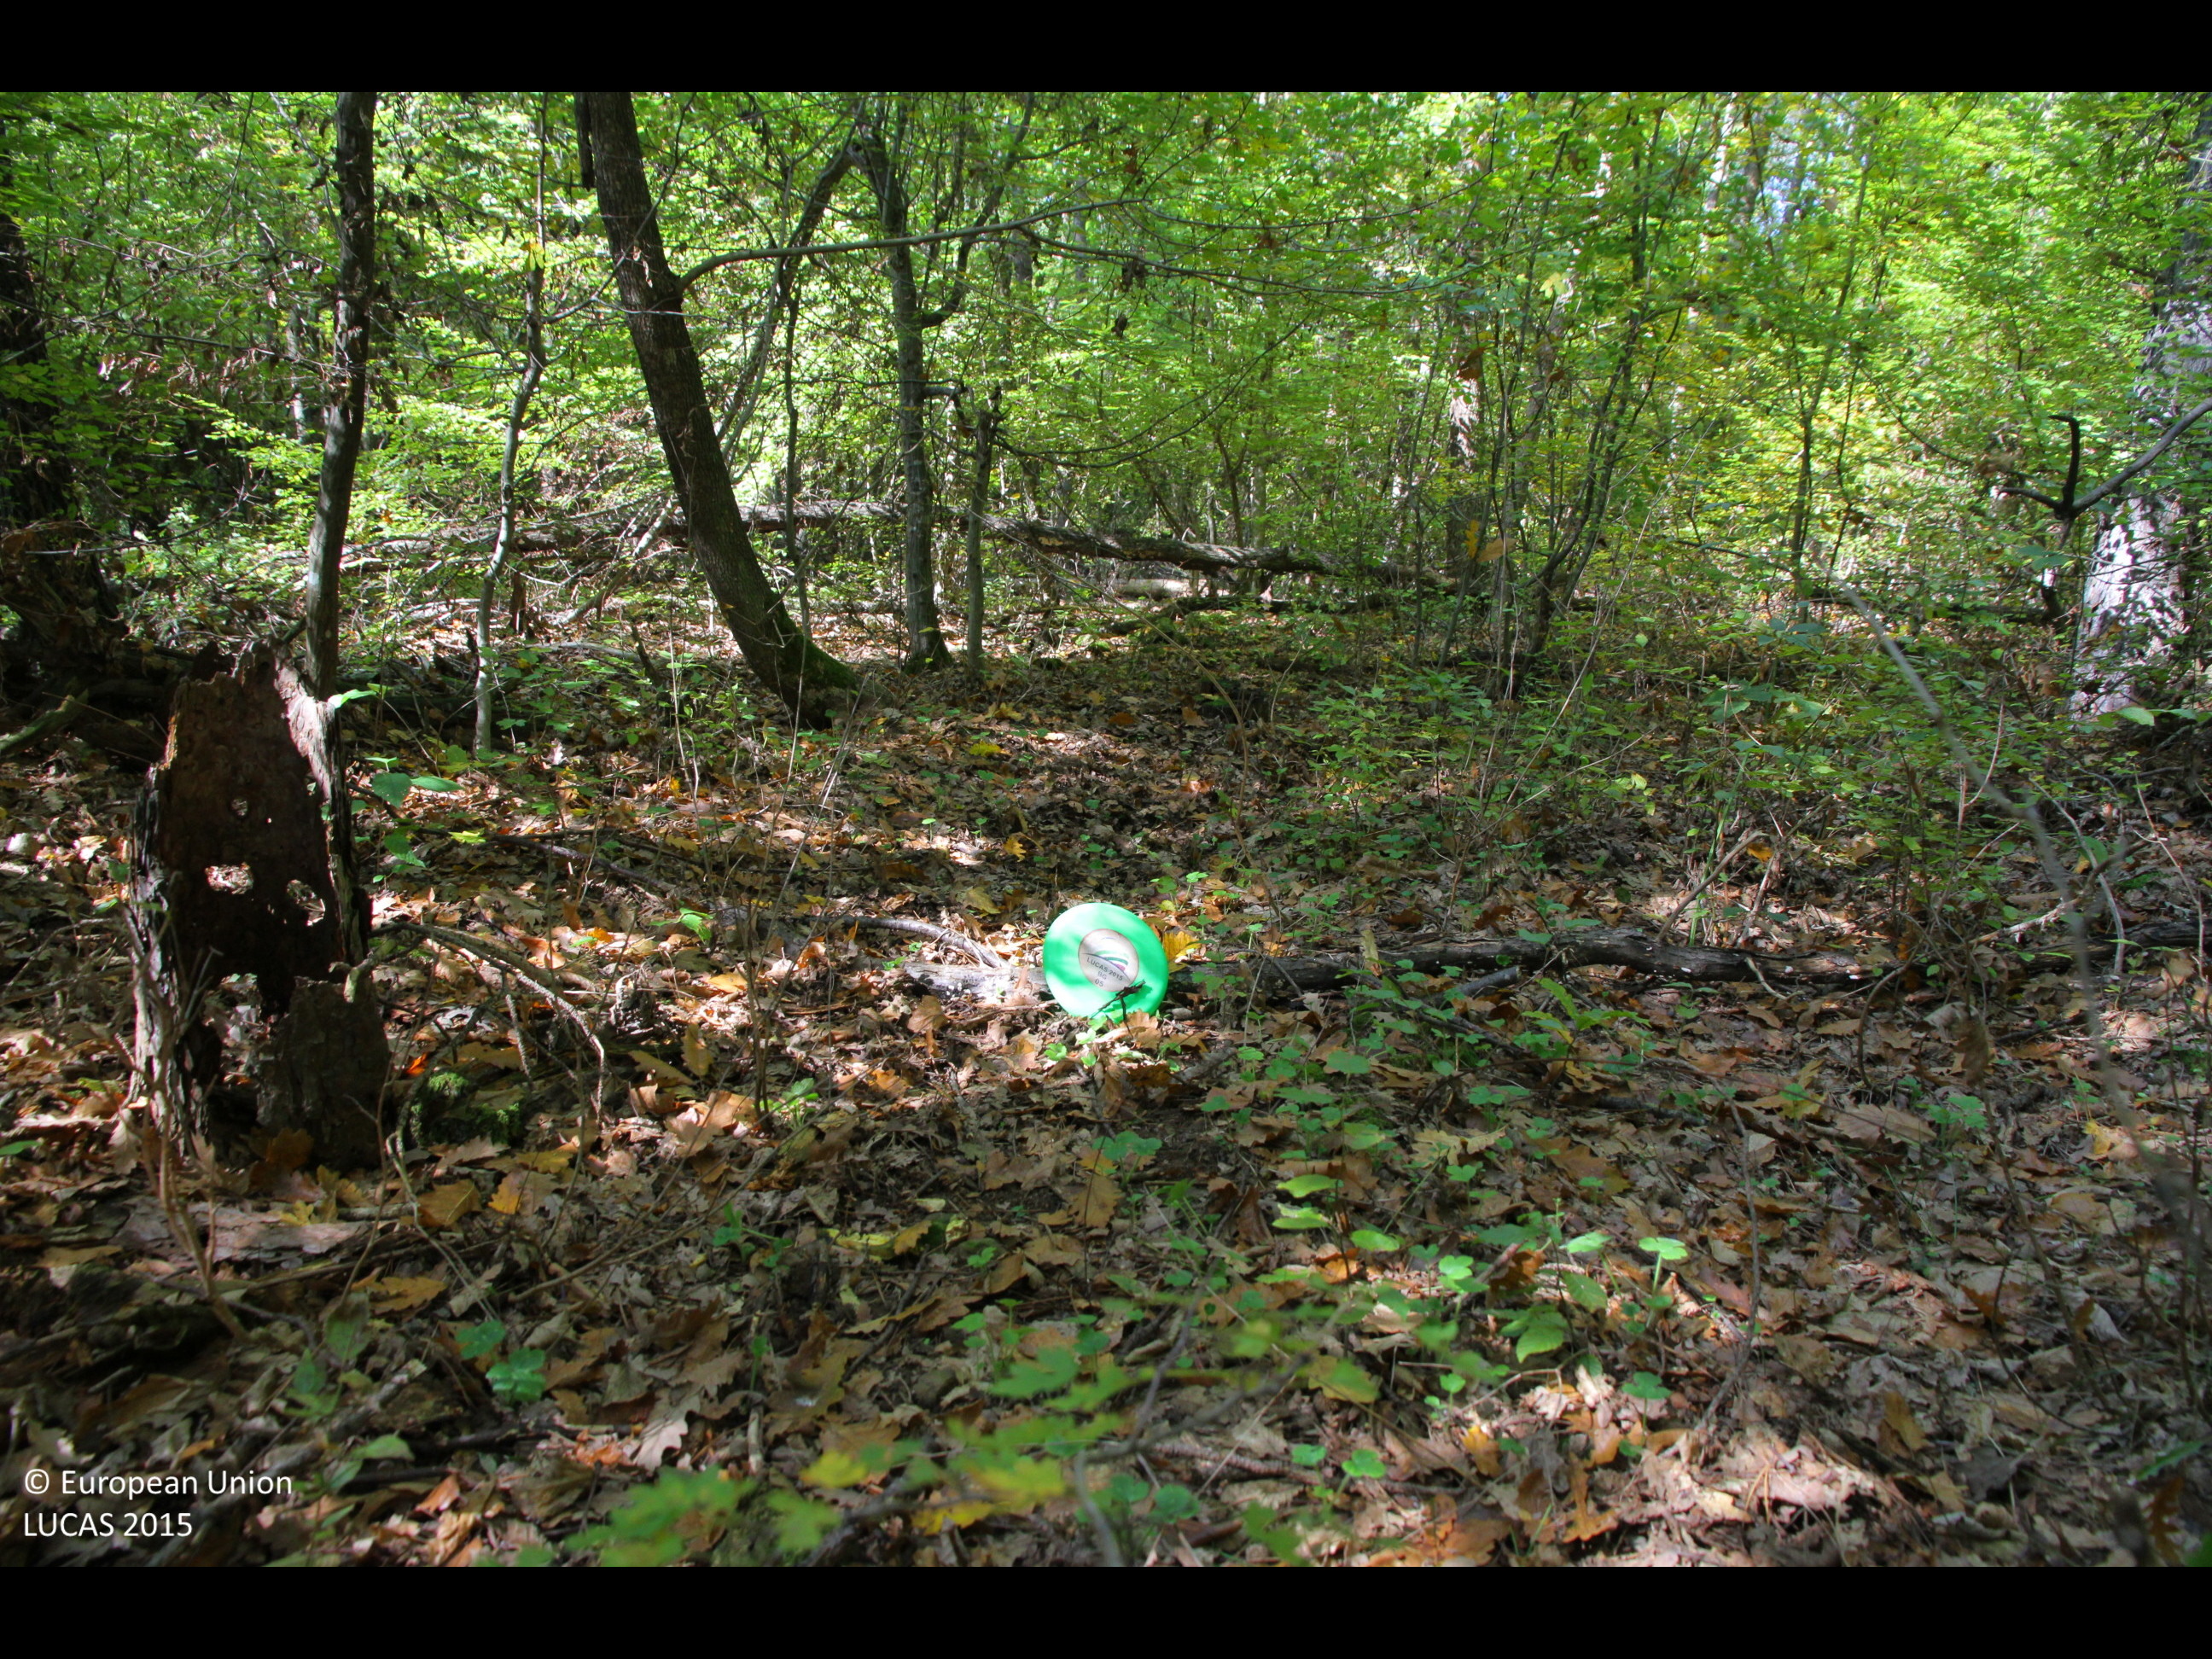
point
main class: Woodland
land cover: Broadleaved woodland
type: mesophytic deciduous forest
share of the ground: > 75 %
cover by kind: broadleaved forest trees 100 %
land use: Forestry
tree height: > 5 m
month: October
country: BG
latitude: 43.0202
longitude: 26.9329
